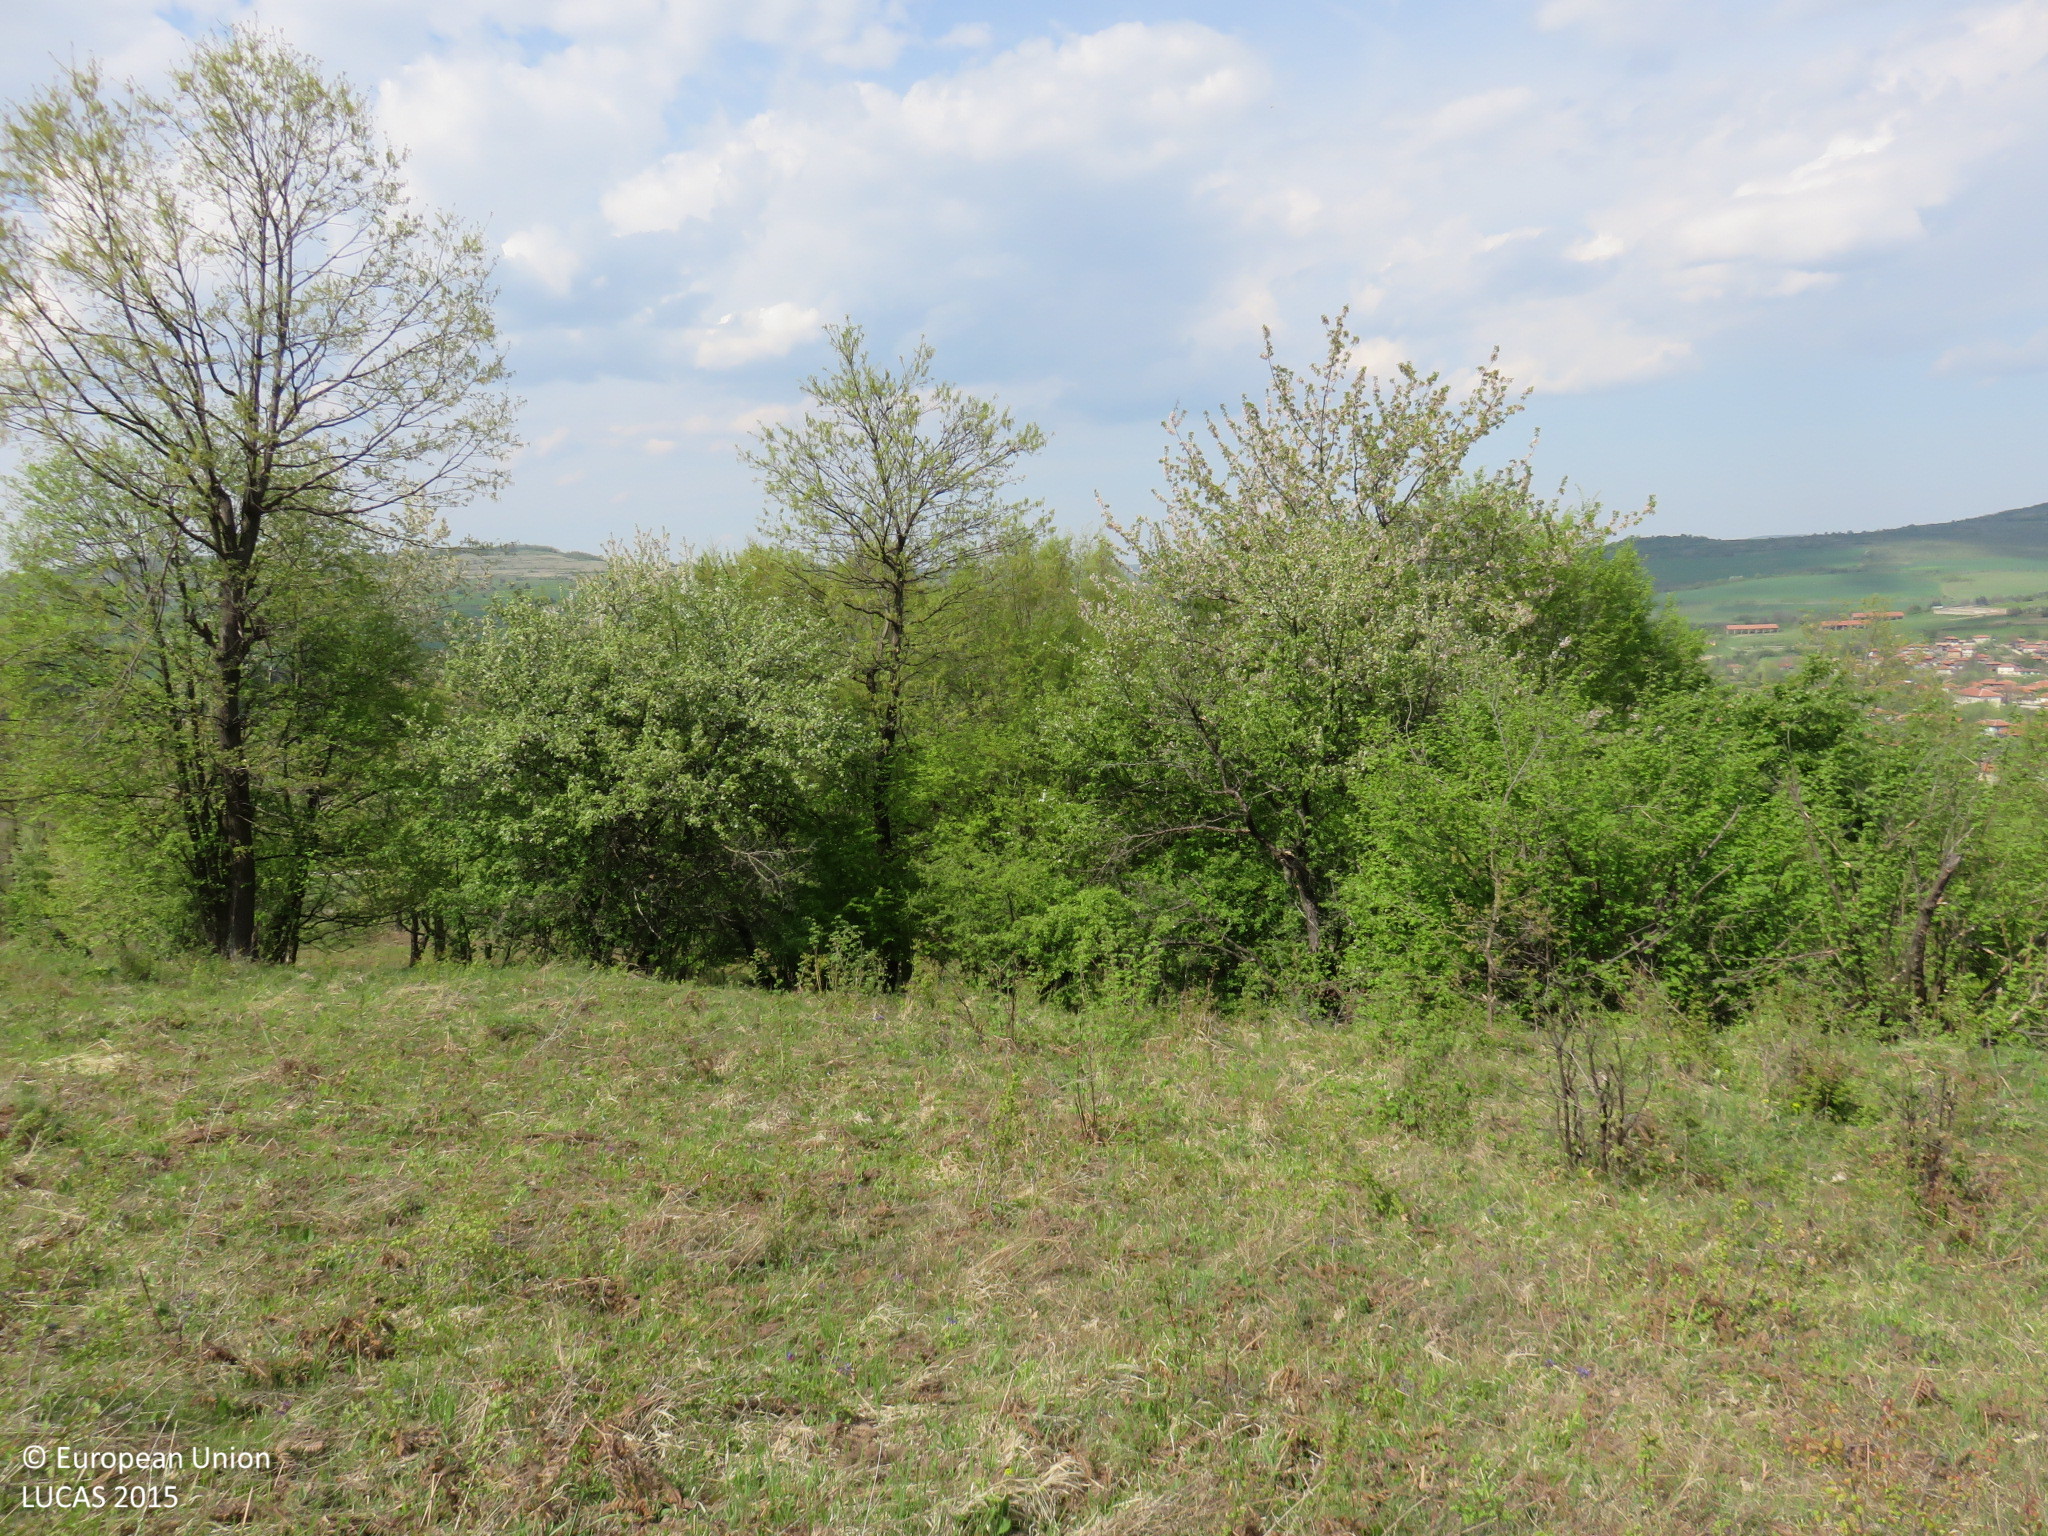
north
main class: Grassland
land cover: Grassland without tree/shrub cover
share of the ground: > 75 %
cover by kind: herbaceous plants 100 %
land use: Agriculture (excluding fallow land and kitchen gardens)
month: April
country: BG
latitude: 43.0328
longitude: 24.8777
